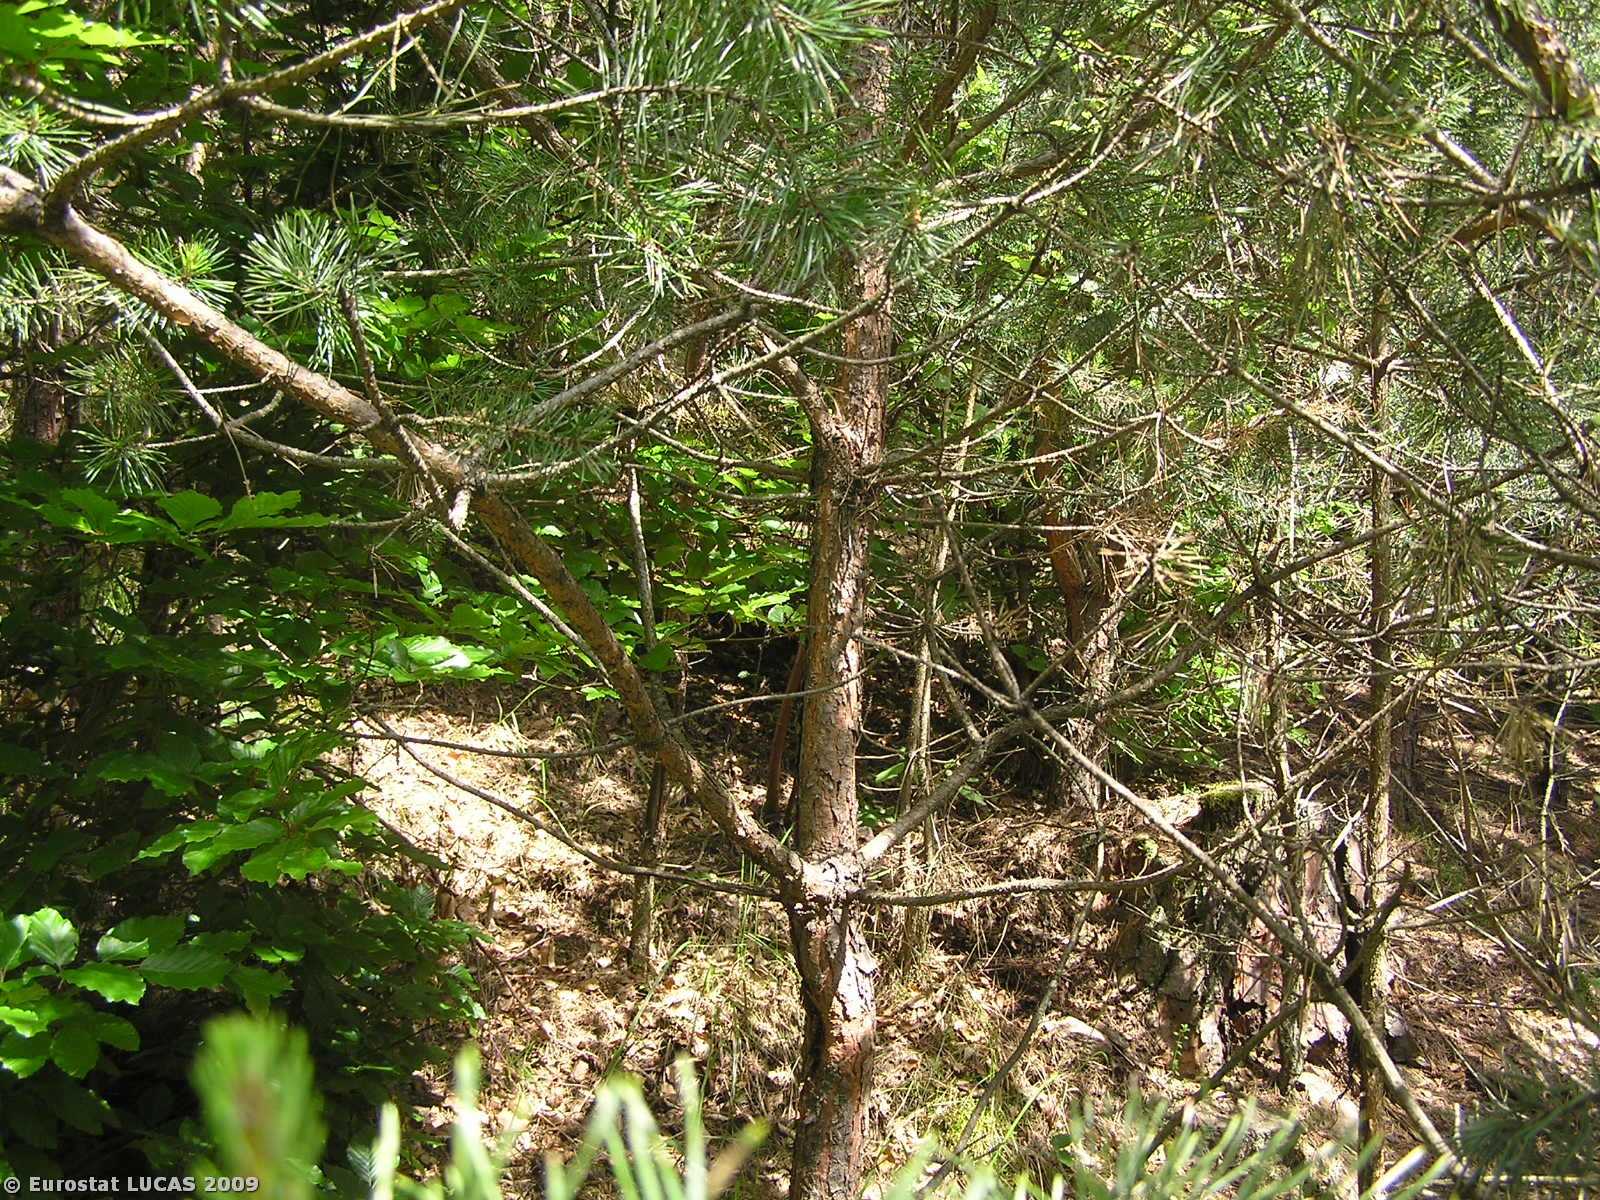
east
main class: Woodland
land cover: Mixed woodland
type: hemiboreal forest and nemoral coniferous forest and mixed broadleaved-coniferous forest
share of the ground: > 75 %
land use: Forestry
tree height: > 5 m
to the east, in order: Mixed woodland; Coniferous woodland
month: June
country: CZ
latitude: 49.8634
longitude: 14.8854
